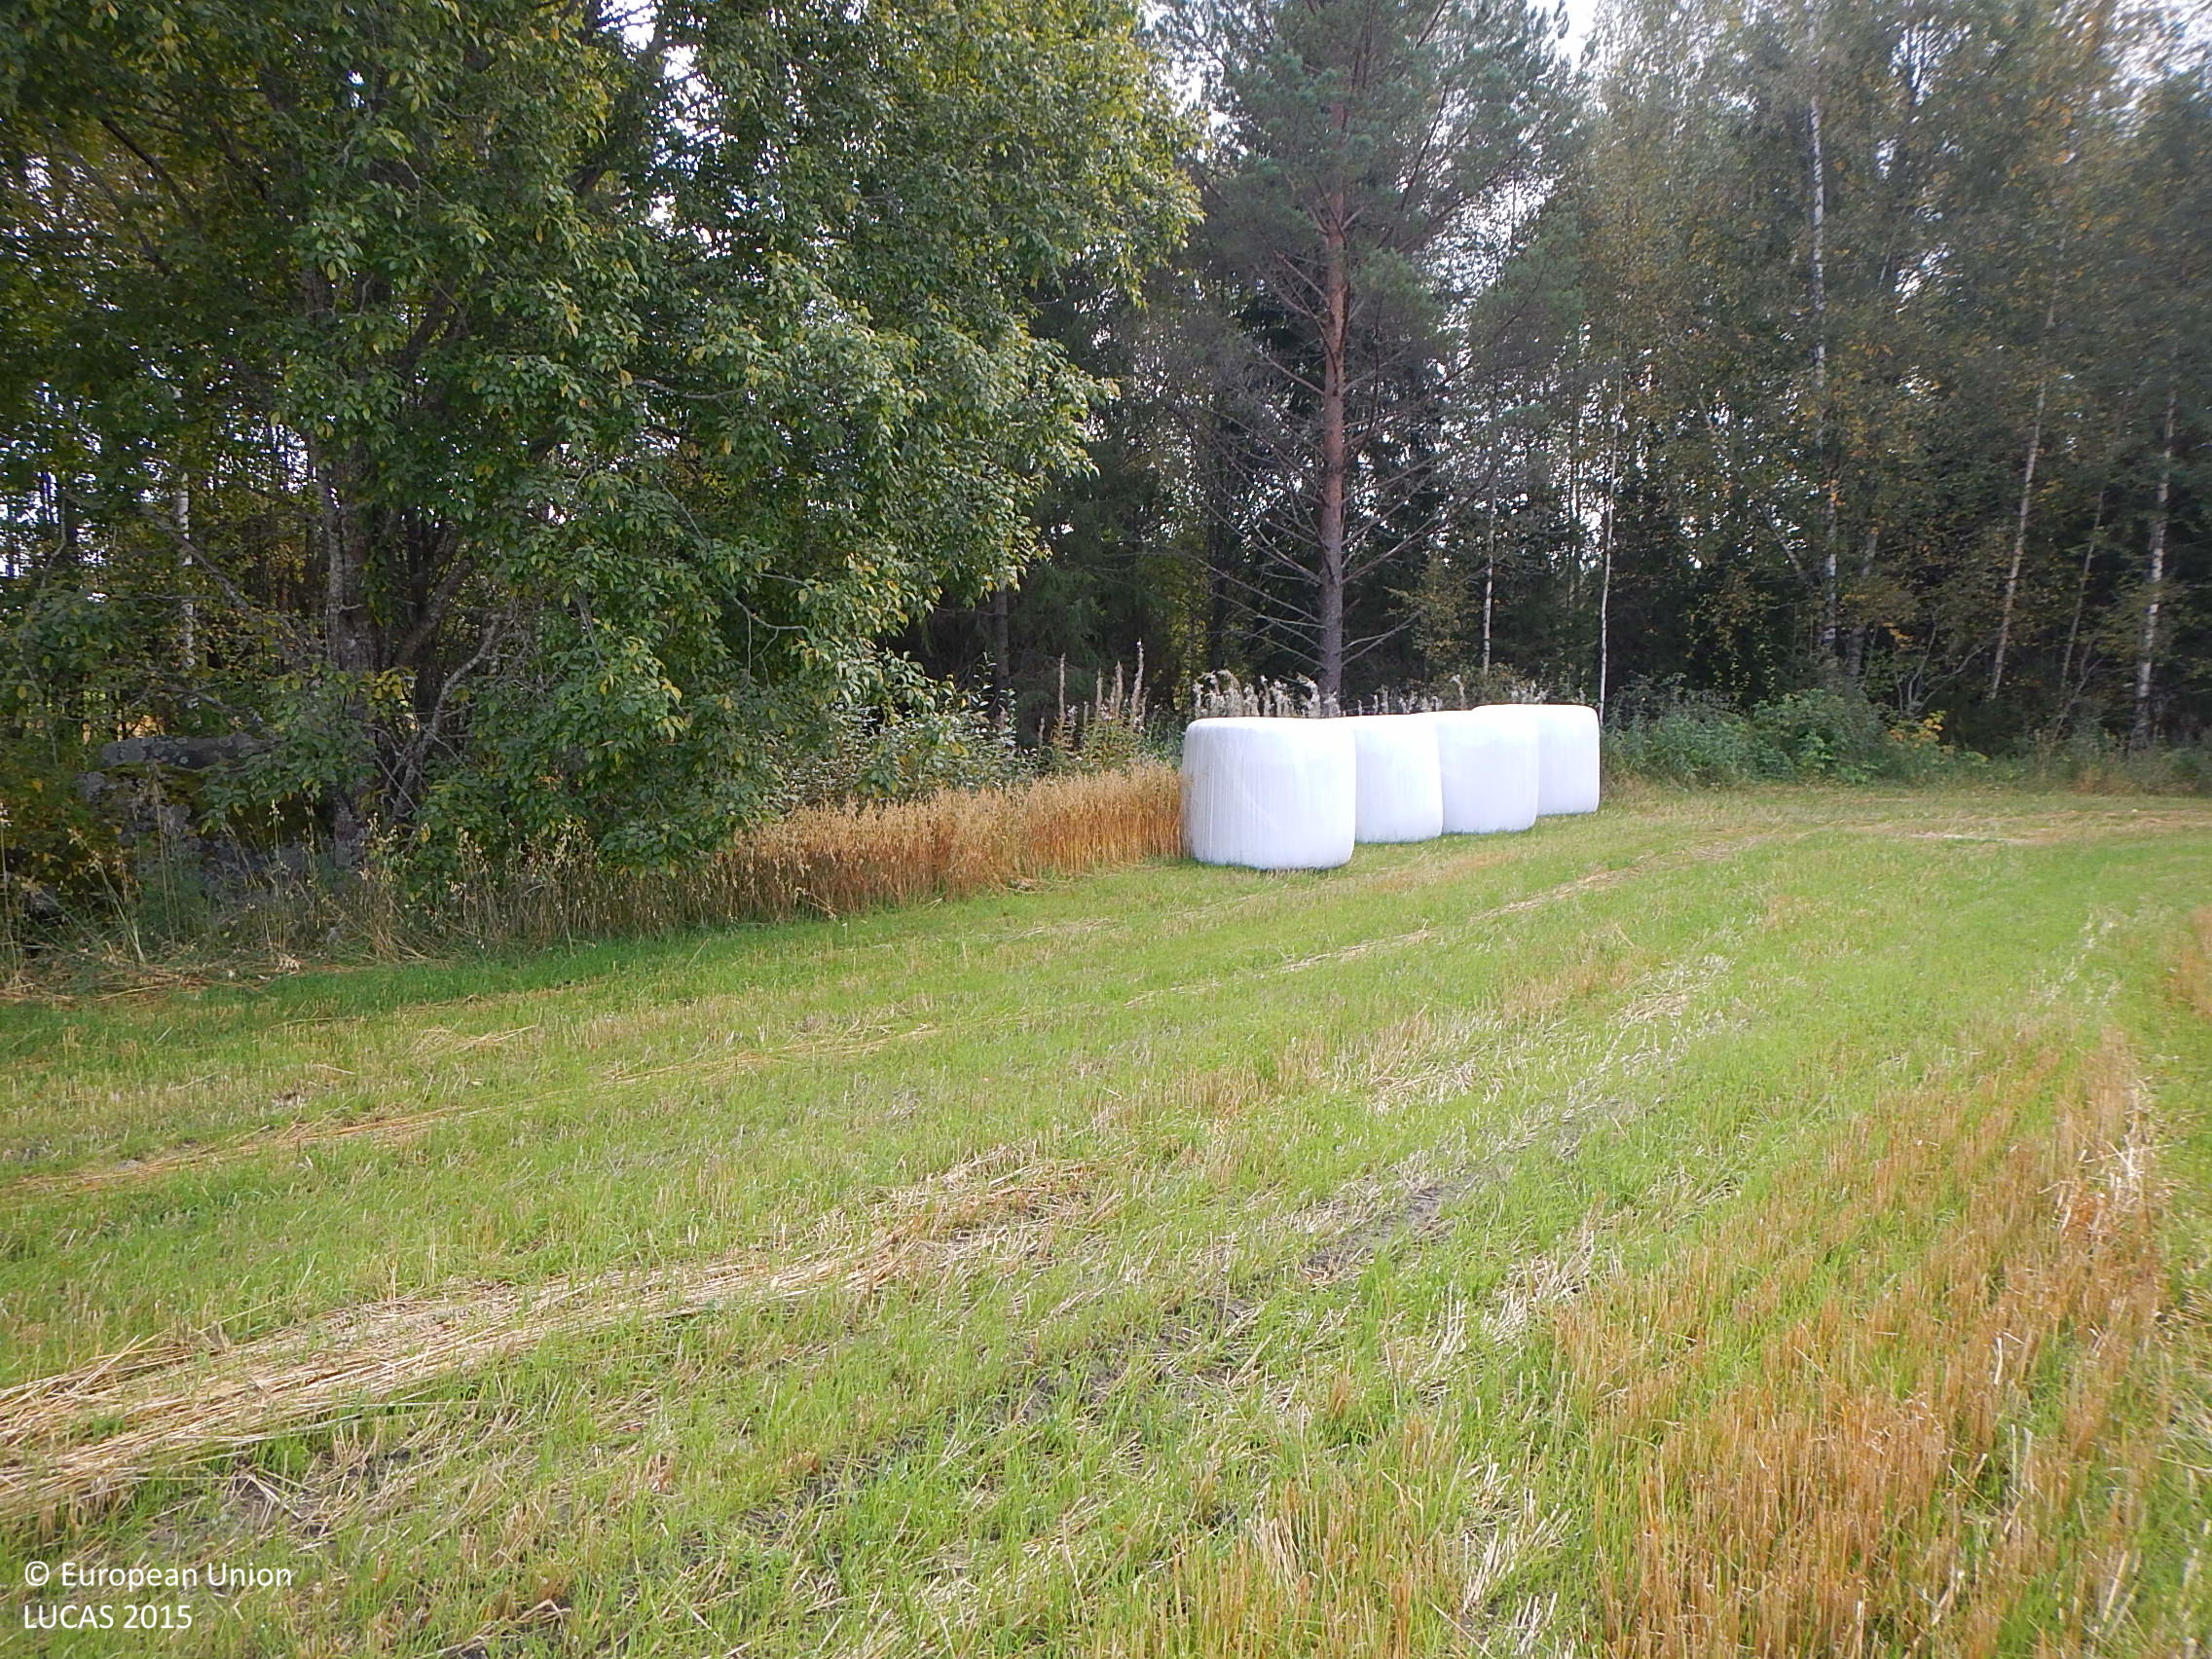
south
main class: Cropland
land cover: Oats
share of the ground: > 75 %
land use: Agriculture (excluding fallow land and kitchen gardens)
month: September
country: FI
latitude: 61.6094
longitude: 22.3335
